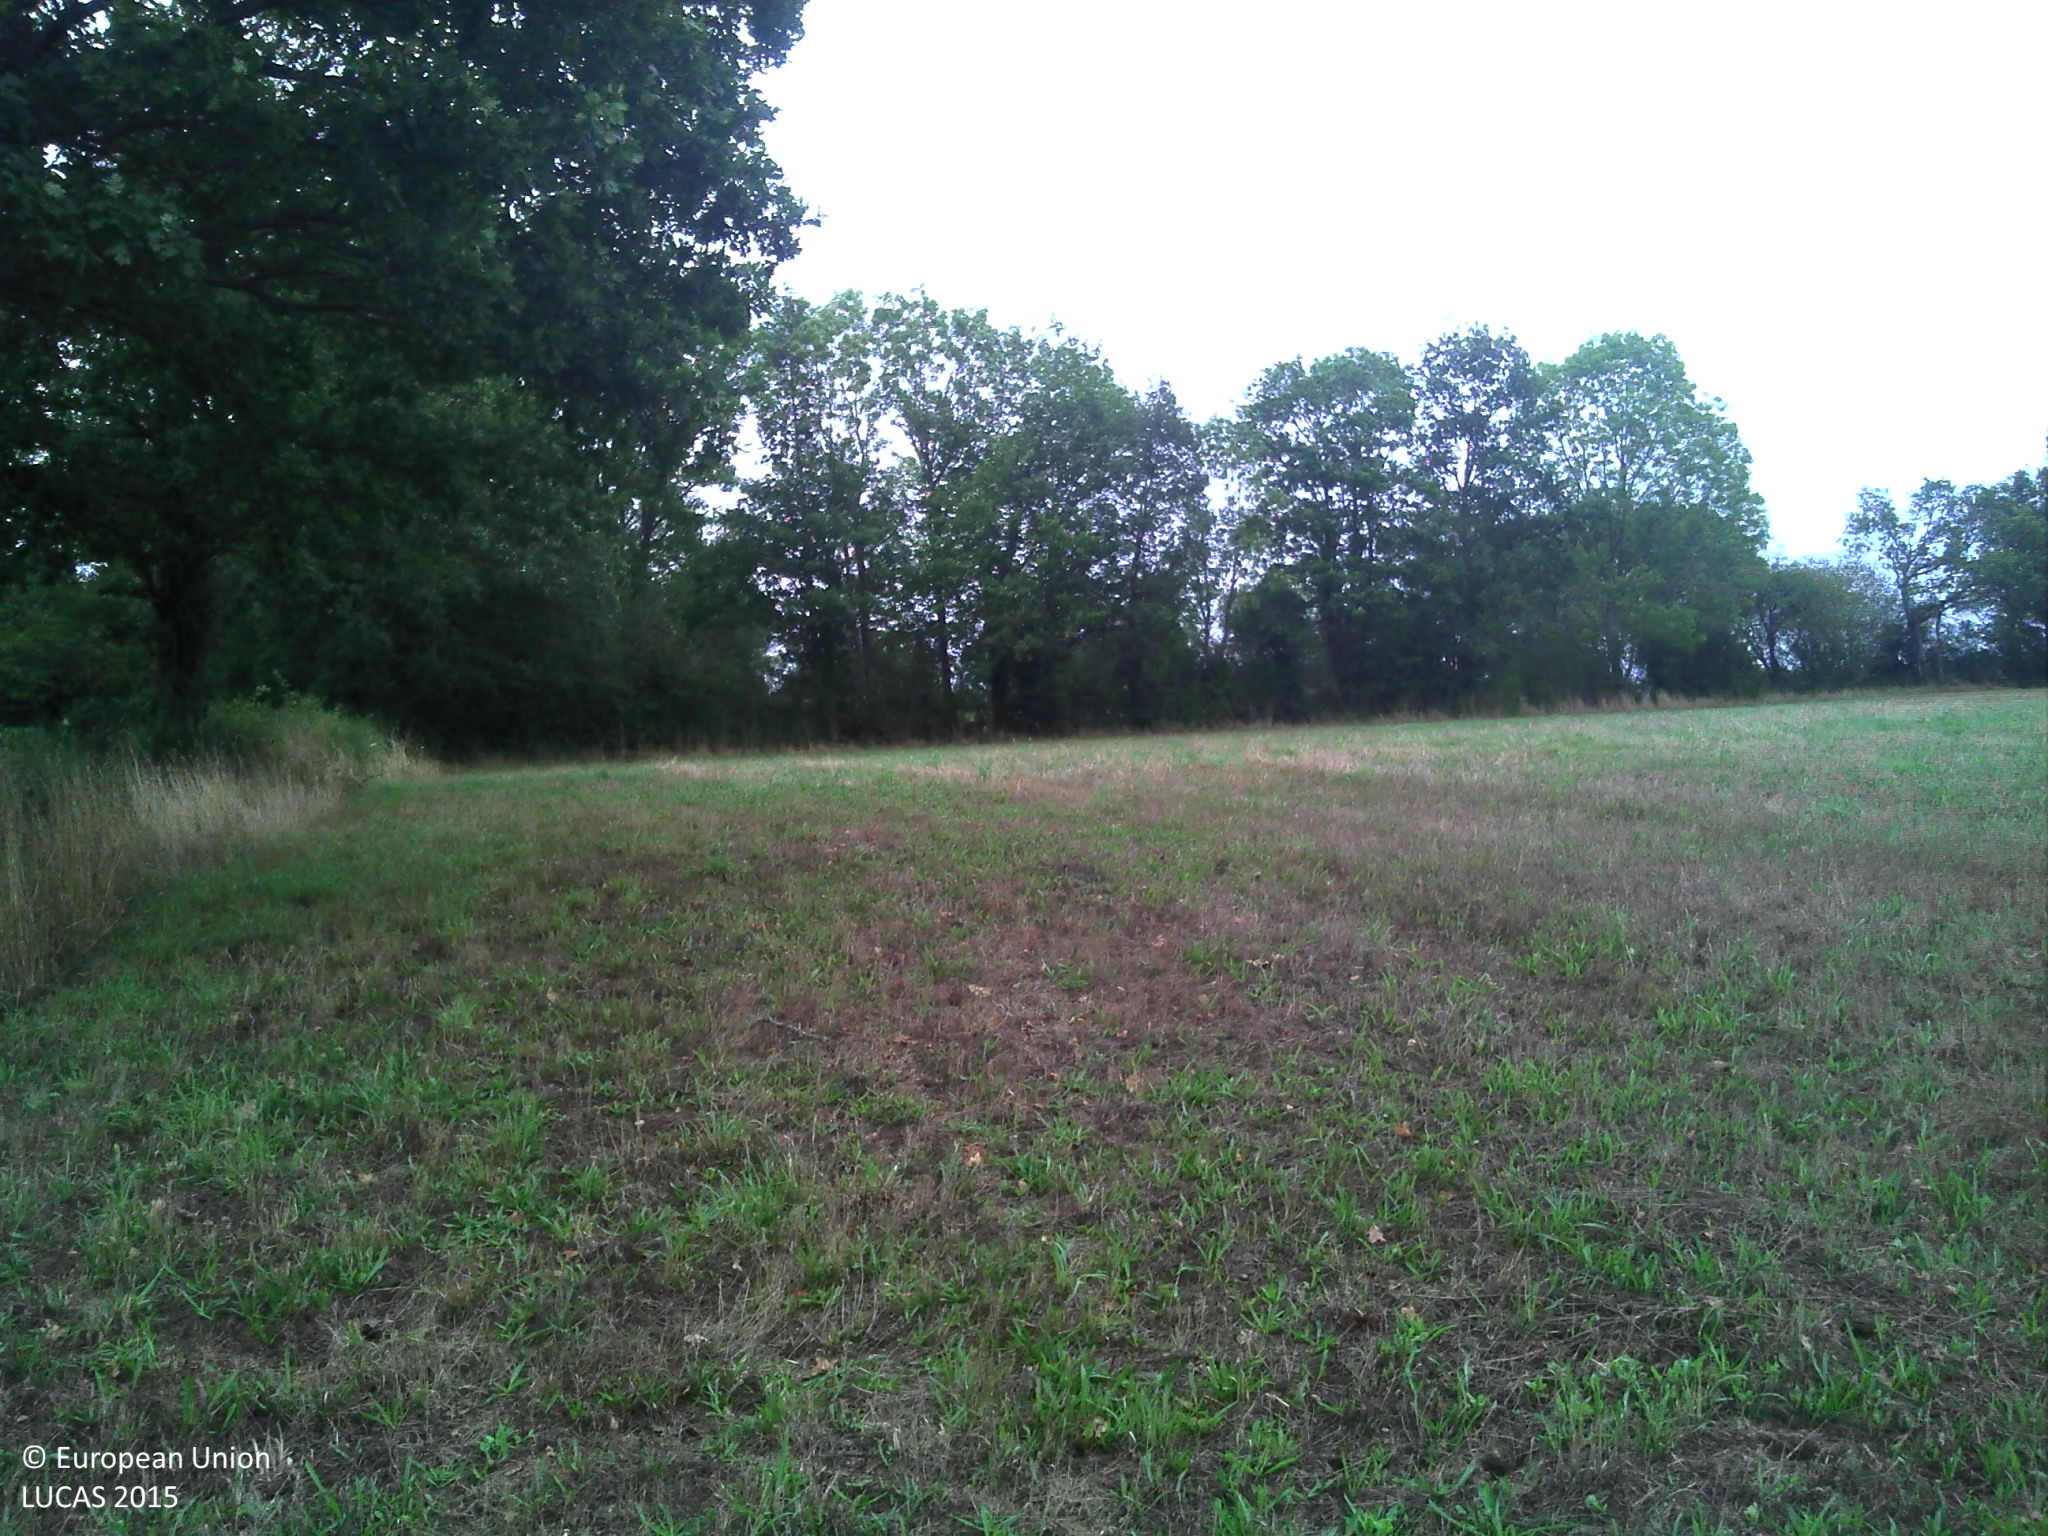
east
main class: Grassland
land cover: Grassland without tree/shrub cover
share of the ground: > 75 %
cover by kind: herbaceous plants 100 %
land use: Agriculture (excluding fallow land and kitchen gardens)
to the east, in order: Grassland without tree/shrub cover; Fences; Dry stone walls; Broadleaved woodland; Fences; Grassland without tree/shrub cover; Fences; Managed hedges; Fences; Grassland without tree/shrub cover; Fences; Managed hedges; Fences; Grassland without tree/shrub cover
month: August
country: FR
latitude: 46.1075
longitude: 2.2716
